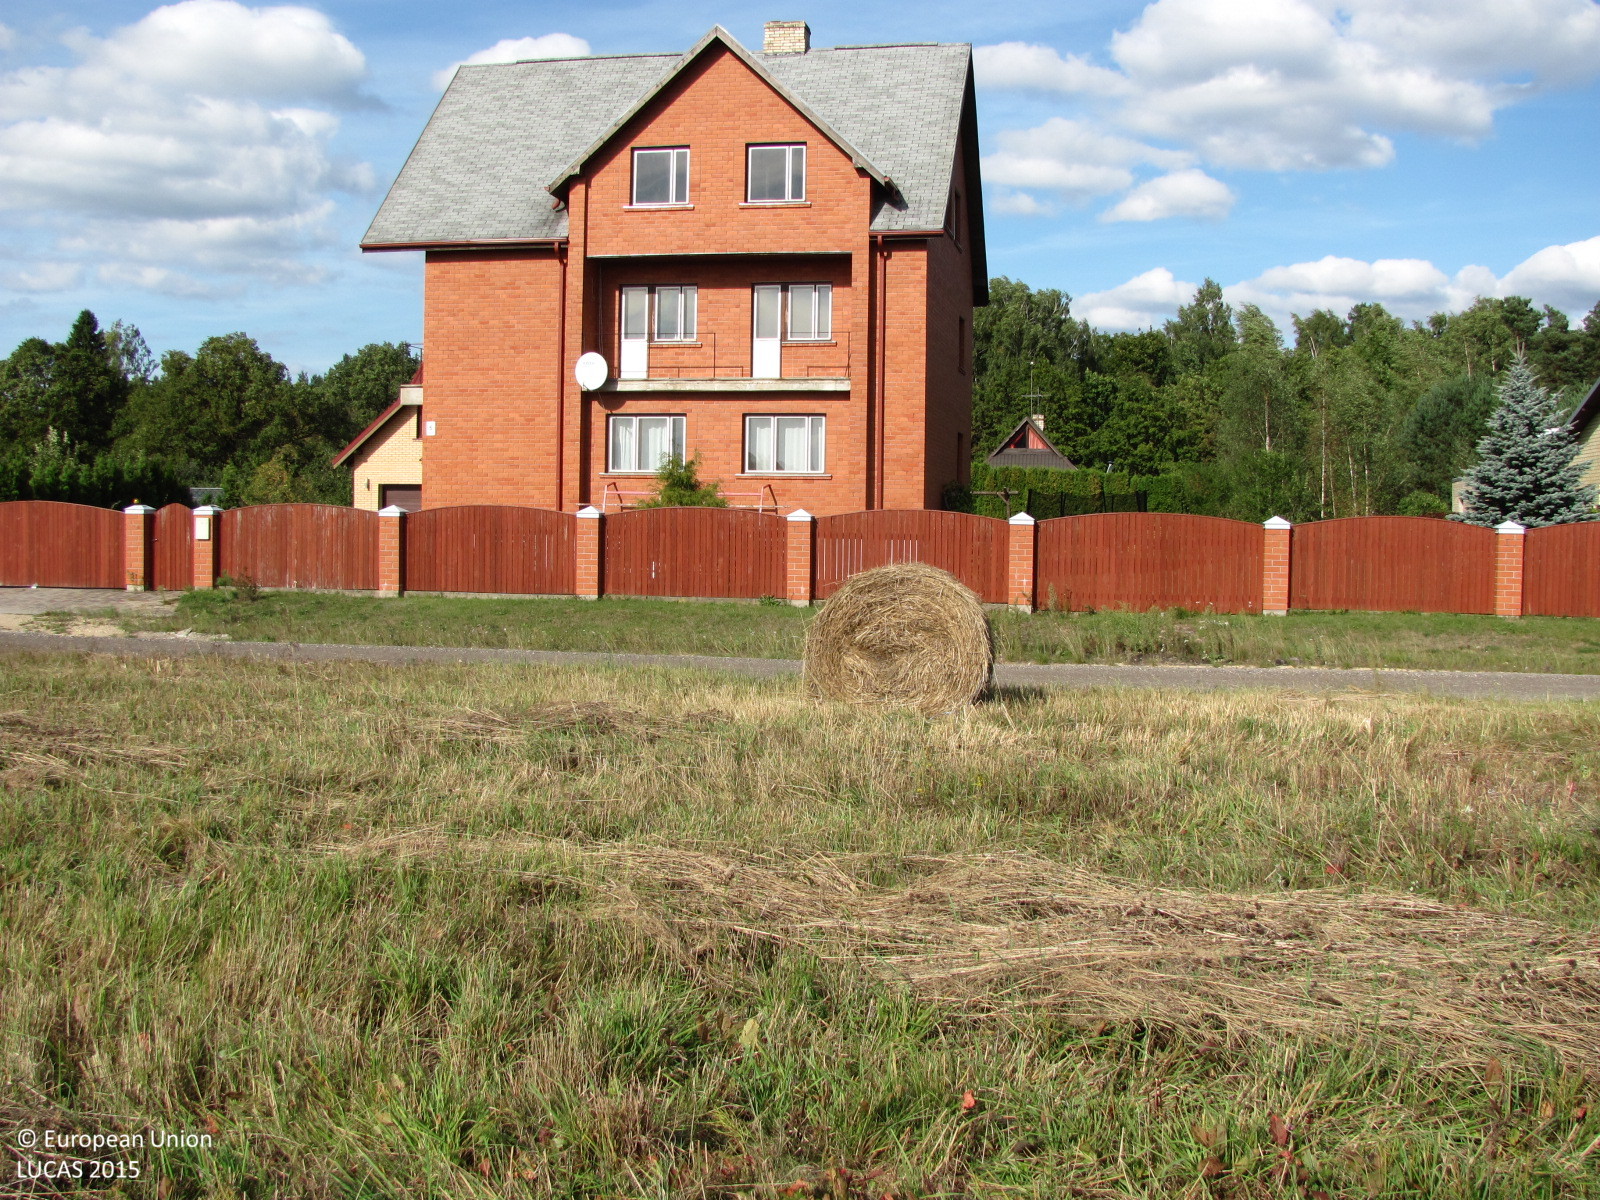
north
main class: Grassland
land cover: Grassland without tree/shrub cover
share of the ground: > 75 %
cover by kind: herbaceous plants 100 %
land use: Agriculture (excluding fallow land and kitchen gardens)
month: September
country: LV
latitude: 57.0763
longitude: 24.3596
